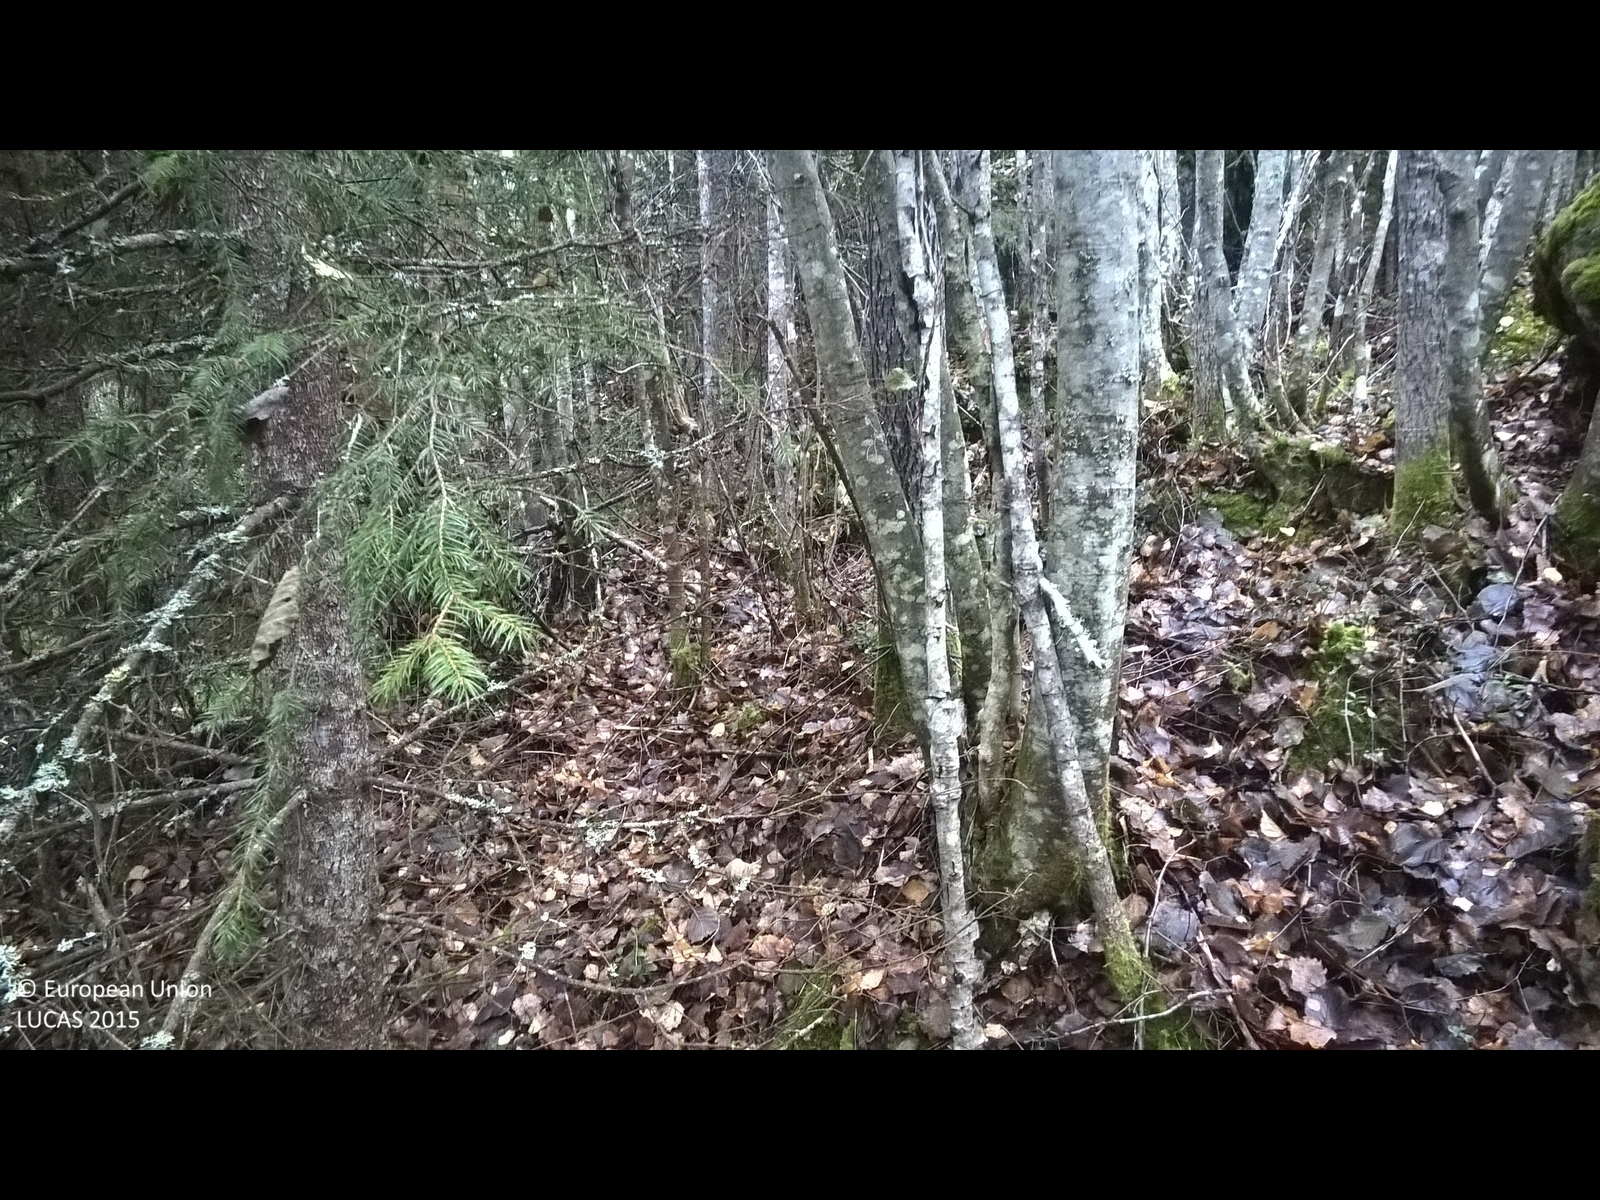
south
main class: Woodland
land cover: Spruce dominated mixed woodland
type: boreal forest
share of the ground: > 75 %
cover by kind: coniferous forest trees 40 %, broadleaved forest trees 40 %, lichens and mosses 20 %
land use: Forestry
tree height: > 5 m
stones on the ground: 10 - 25 %
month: October
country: SE
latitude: 62.8480
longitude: 16.1646
